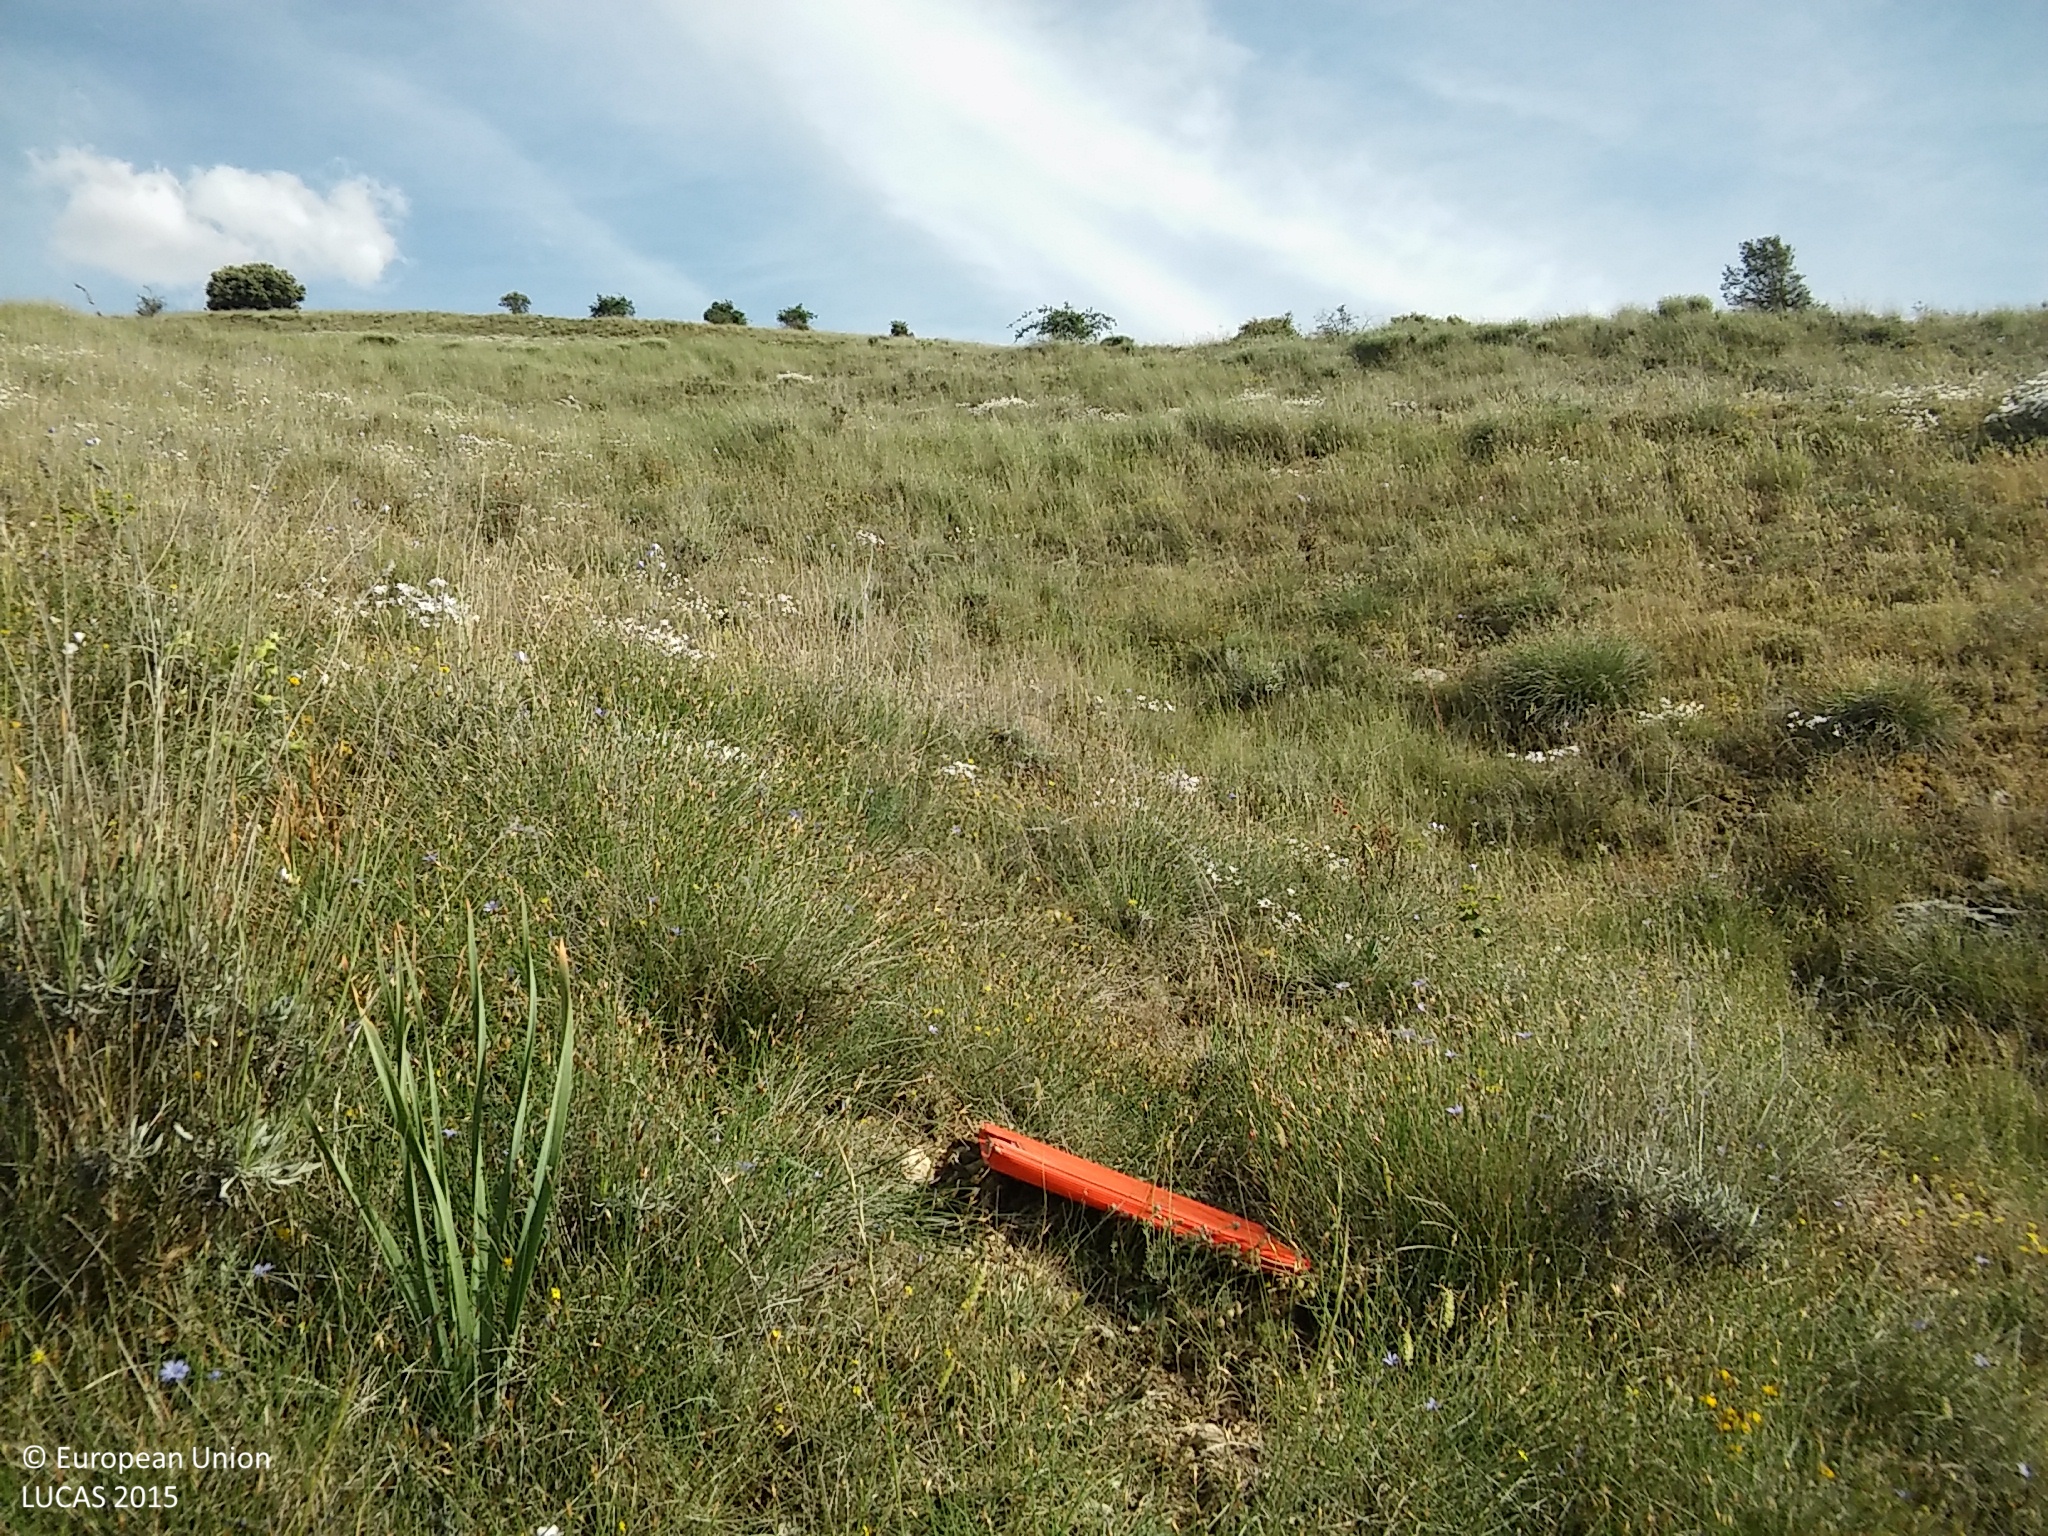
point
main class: Shrubland
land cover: Shrubland without tree cover
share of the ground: 25 - 50 %
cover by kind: shrubs 45 %, herbaceous plants 30 %, unconsolidated bare surface 25 %
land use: Semi-natural and natural areas not in use
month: June
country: ES
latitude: 41.5670
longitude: -3.7349
